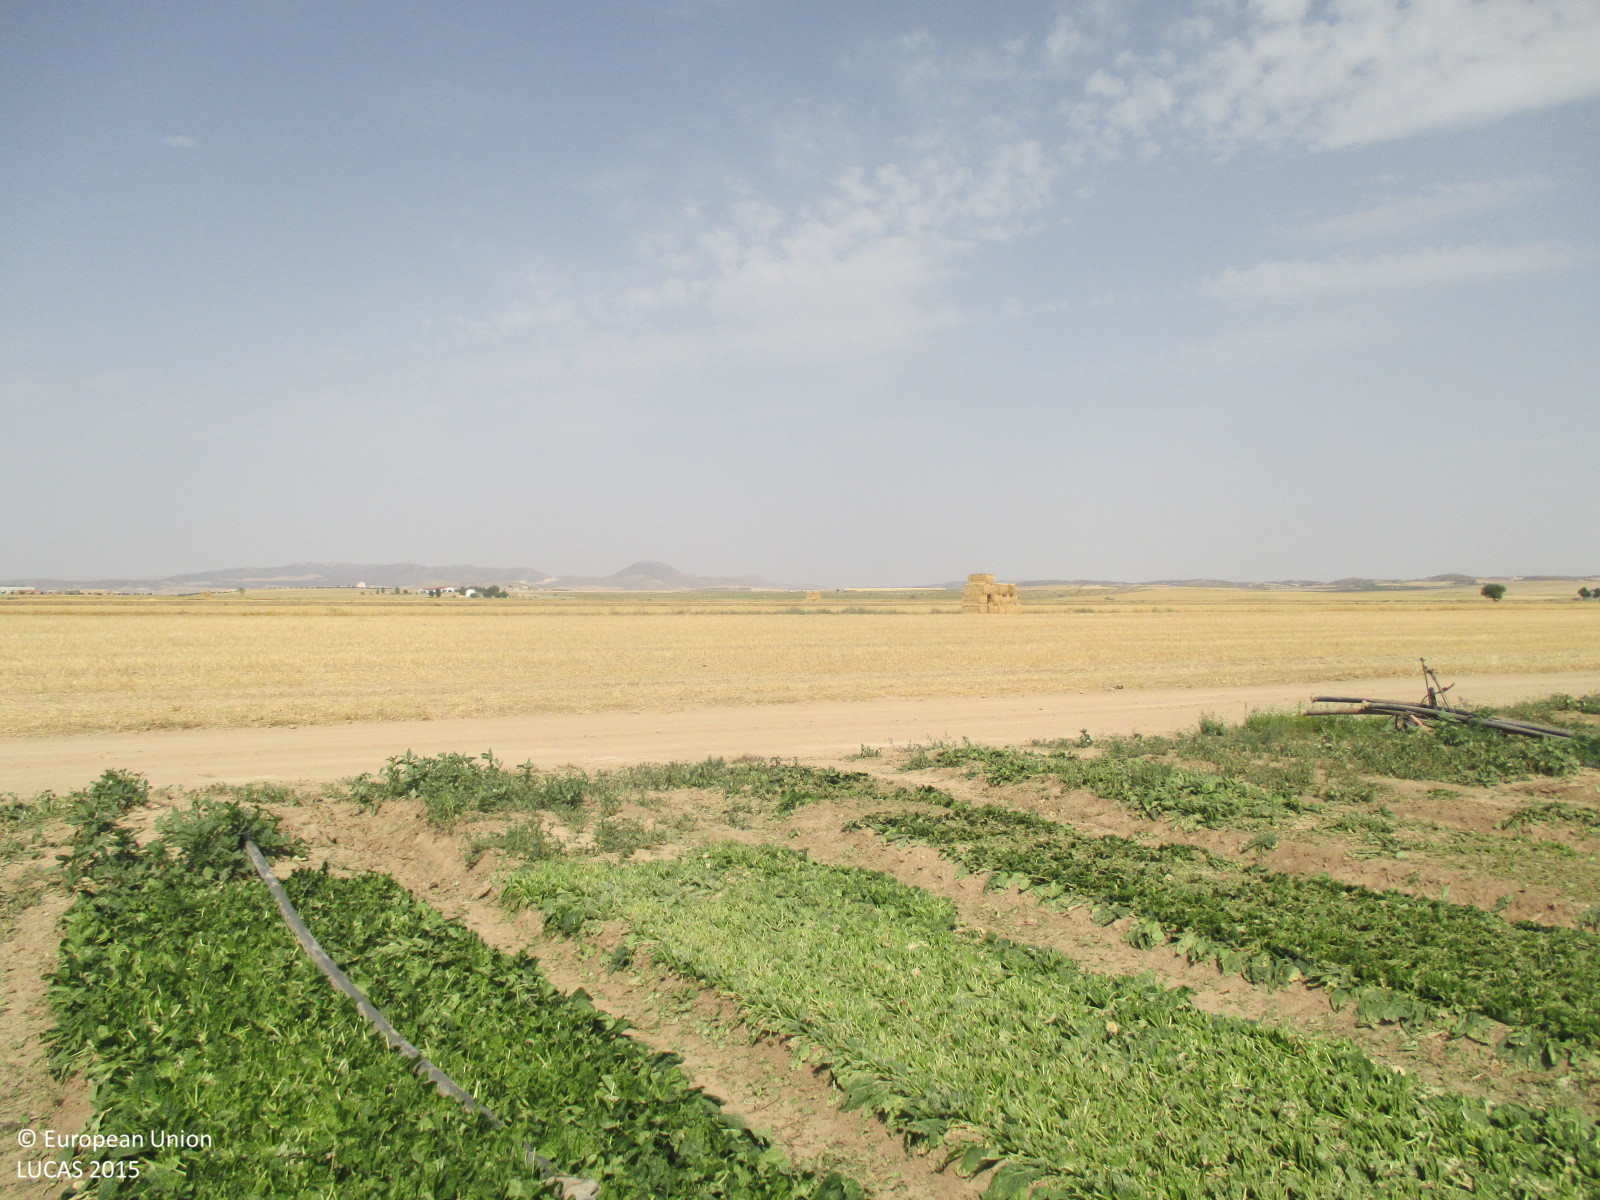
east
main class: Cropland
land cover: Other fresh vegetables
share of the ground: 50 - 75 %
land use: Agriculture (excluding fallow land and kitchen gardens)
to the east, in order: Other fresh vegetables; Grass margins; Other bare soil; Tracks; Grass margins; Other bare soil; Grass margins; Other bare soil
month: July
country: ES
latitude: 37.8652
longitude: -2.4141
